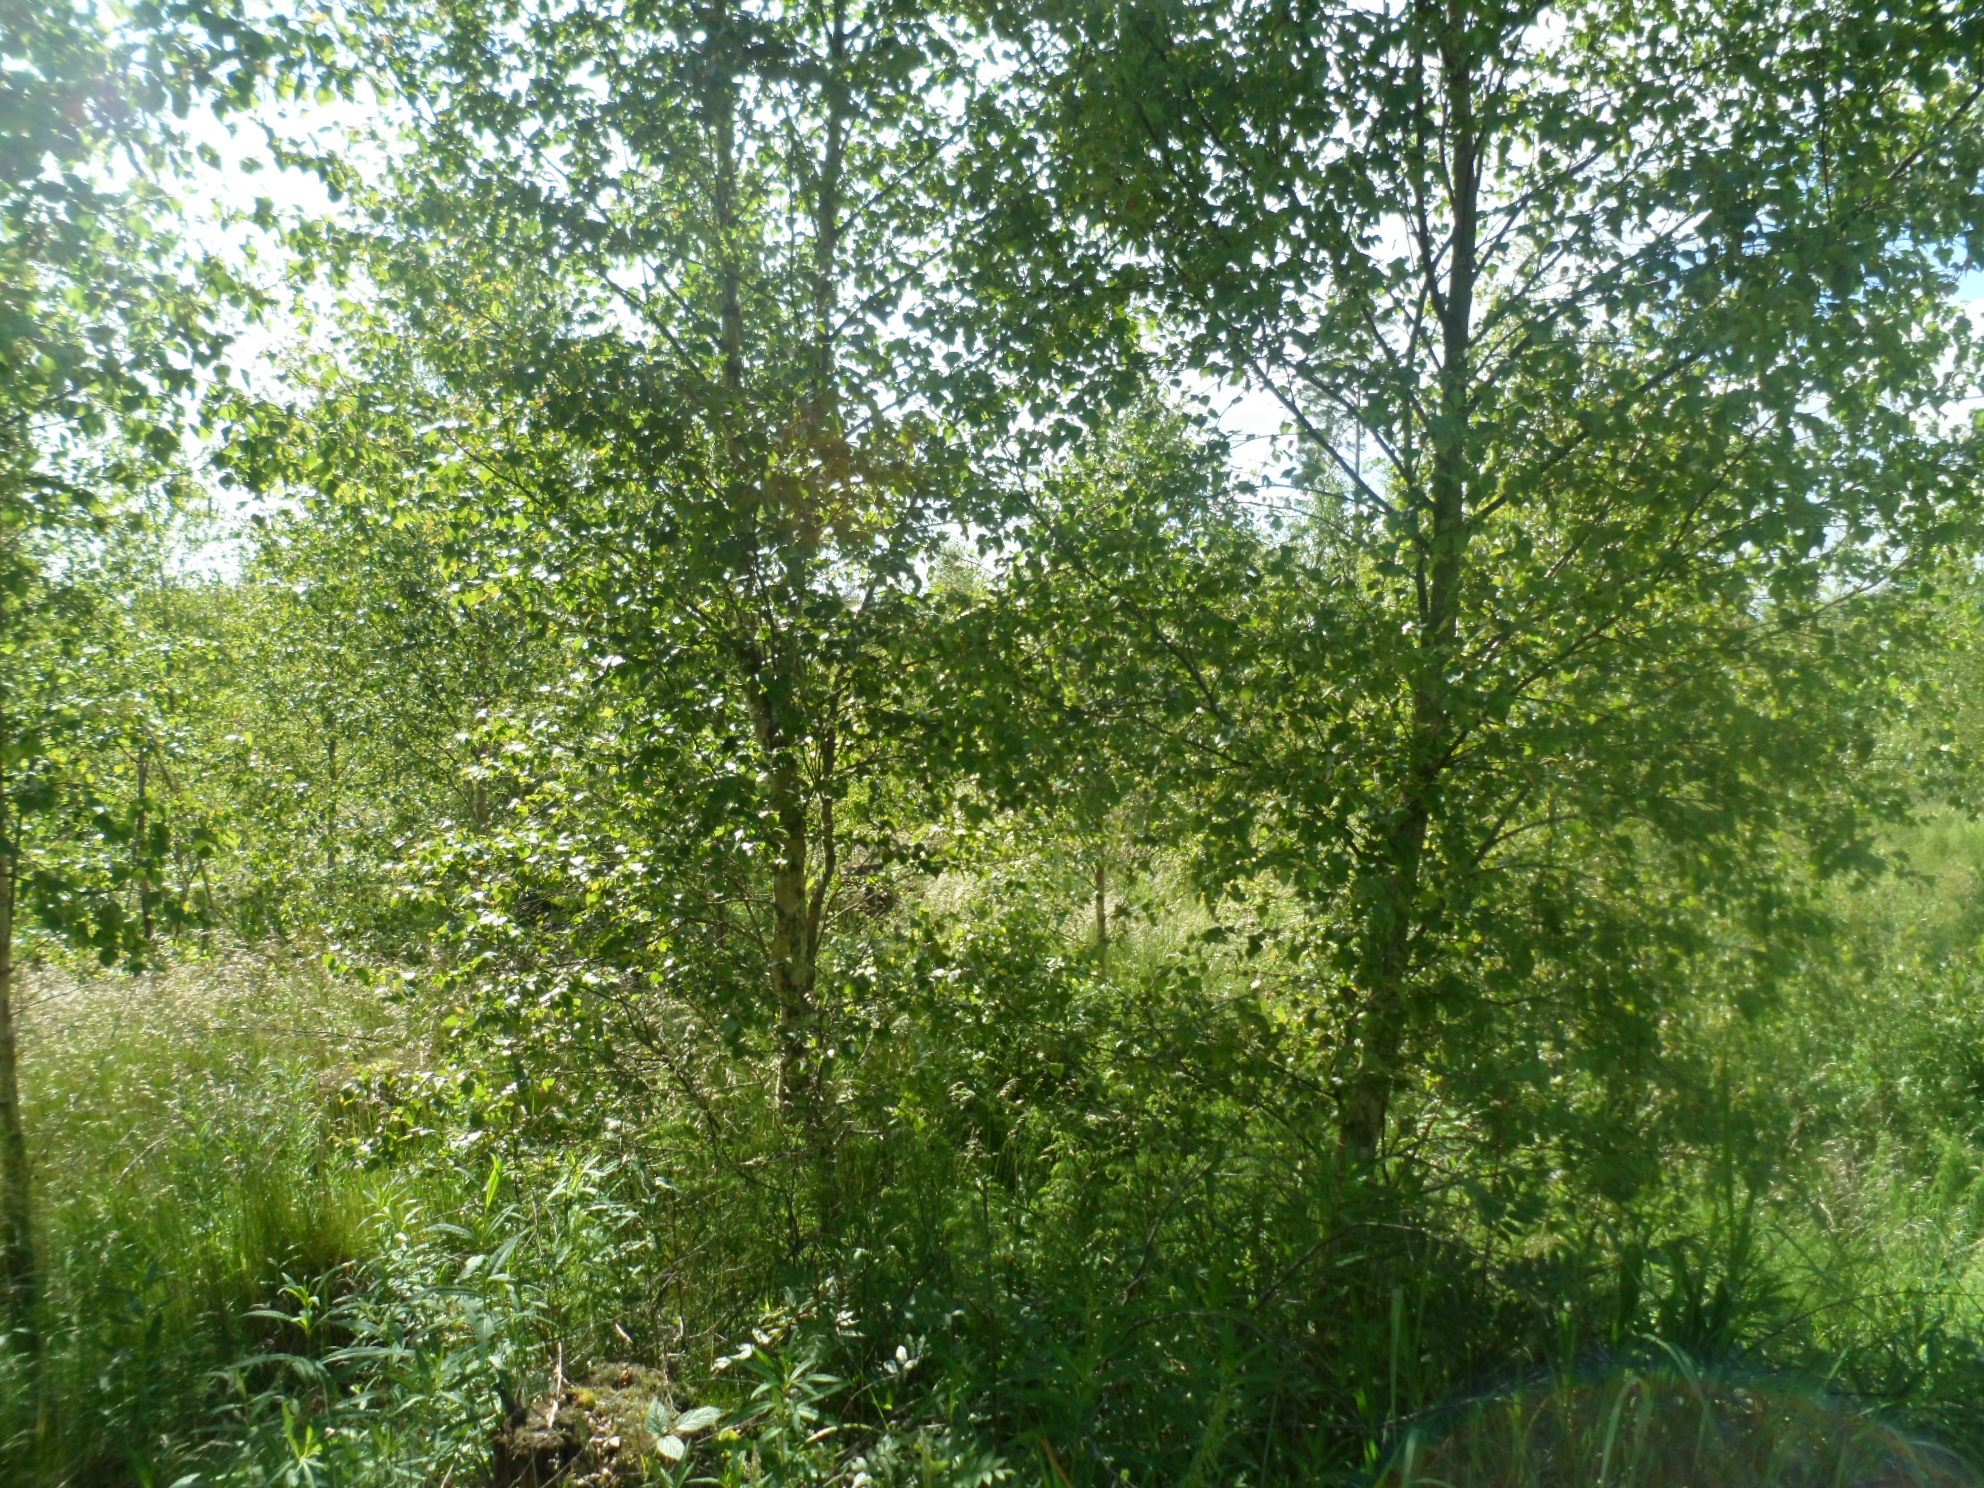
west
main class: Woodland
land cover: Broadleaved woodland
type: hemiboreal forest and nemoral coniferous forest and mixed broadleaved-coniferous forest
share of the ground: 50 - 75 %
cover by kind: broadleaved forest trees 65 %, herbaceous plants 20 %, coniferous forest trees 5 %, shrubs 5 %, lichens and mosses 5 %
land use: Forestry
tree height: < 5 m
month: June
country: SE
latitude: 56.9836
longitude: 14.1926
